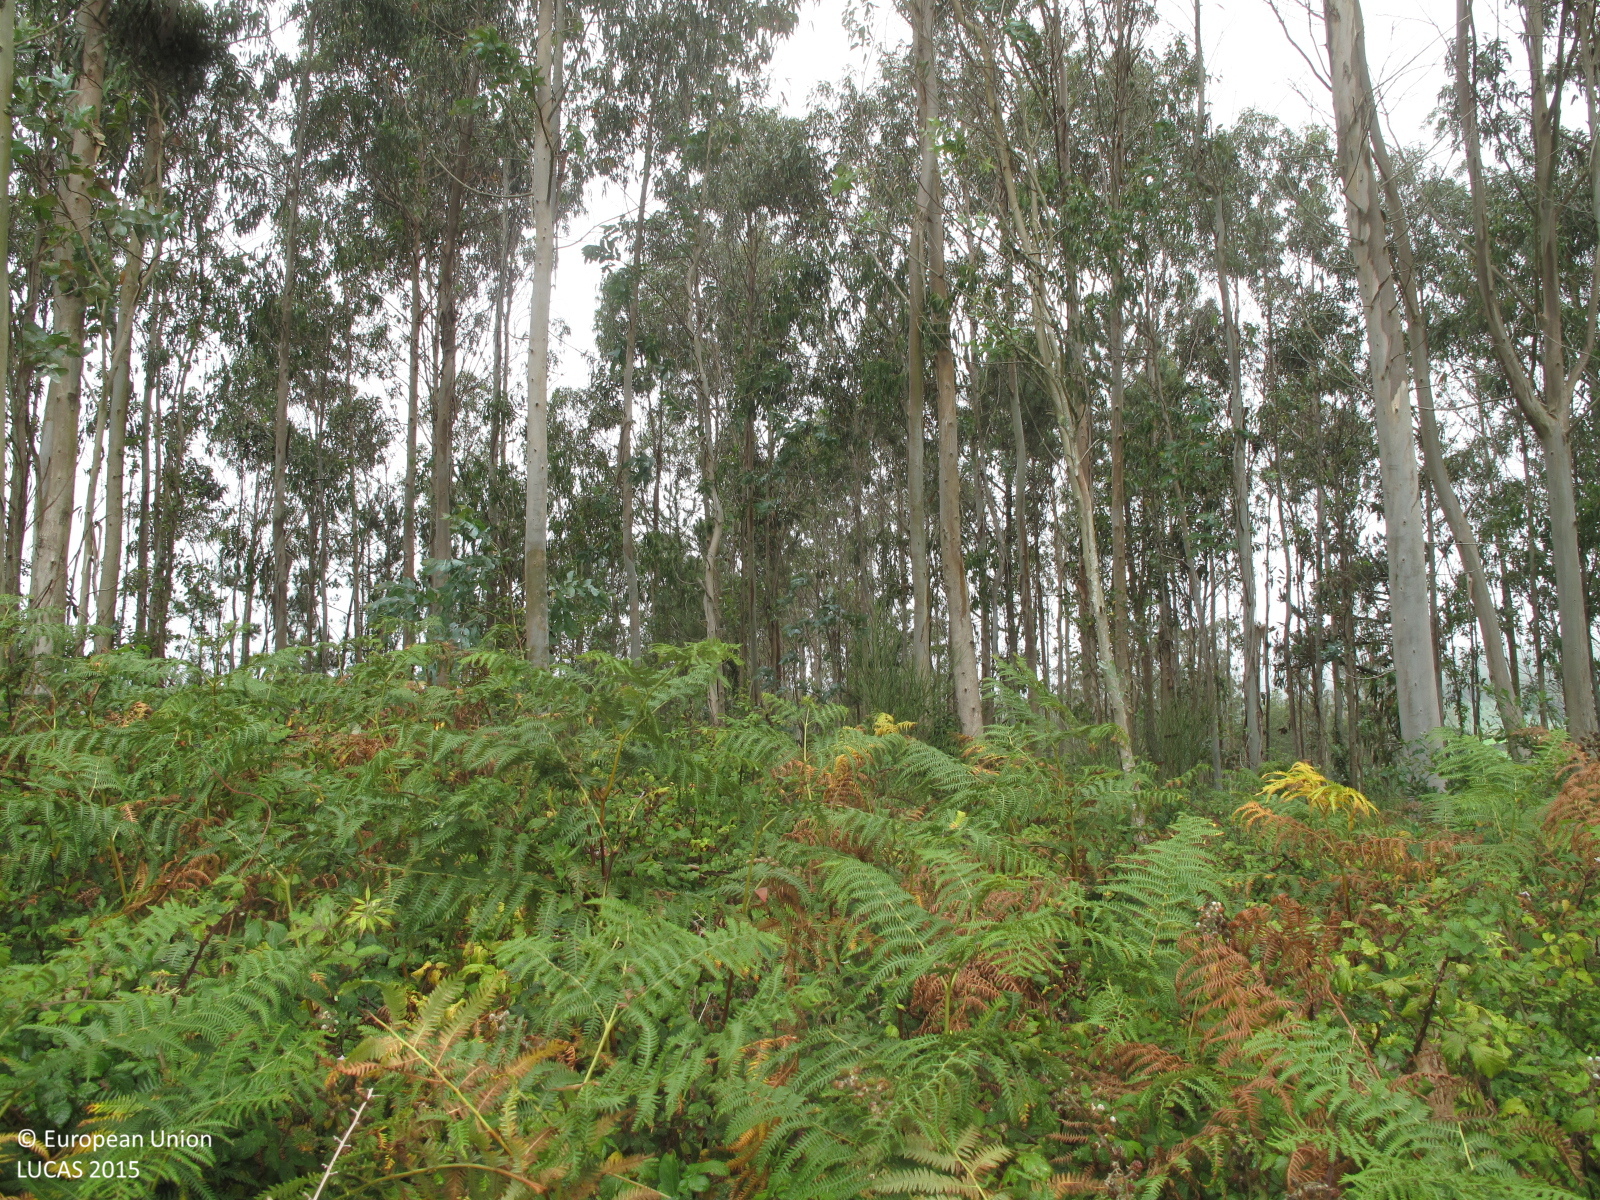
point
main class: Woodland
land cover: Broadleaved woodland
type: exotic forest
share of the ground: 50 - 75 %
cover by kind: broadleaved forest trees 50 %, shrubs 30 %, herbaceous plants 20 %
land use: Forestry
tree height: > 5 m
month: July
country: ES
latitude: 43.0289
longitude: -9.2378
